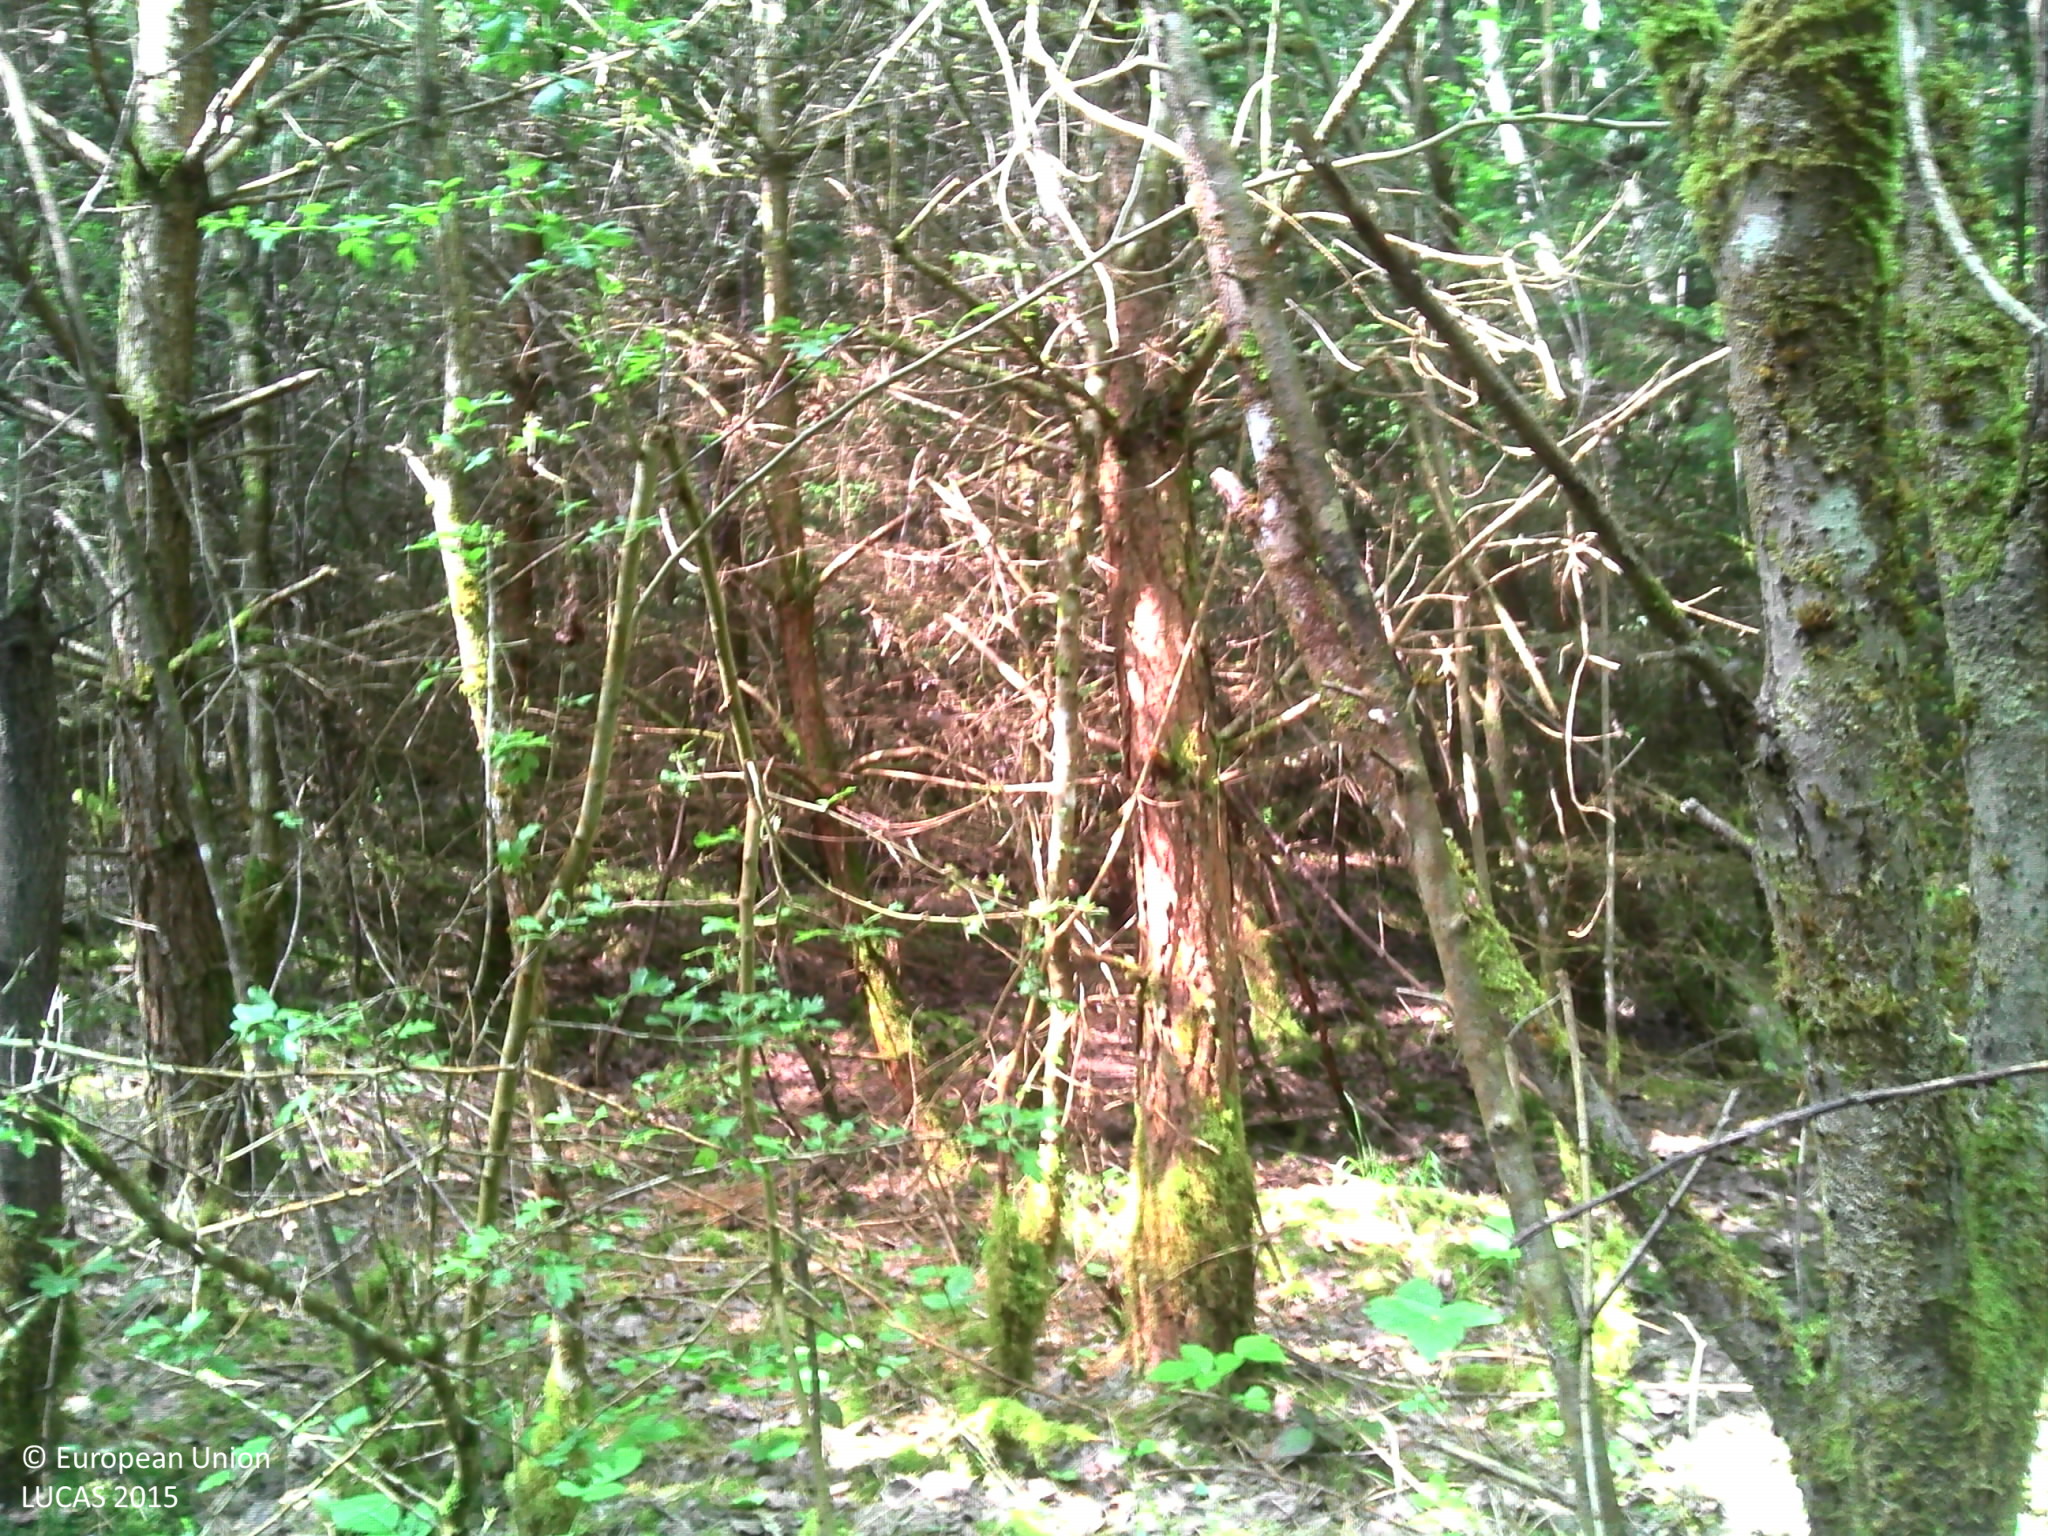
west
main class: Woodland
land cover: Spruce dominated mixed woodland
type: beech forest
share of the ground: > 75 %
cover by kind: coniferous forest trees 45 %, broadleaved forest trees 45 %, herbaceous plants 10 %
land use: Forestry
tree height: > 5 m
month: May
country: FR
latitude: 47.9537
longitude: 6.0237
